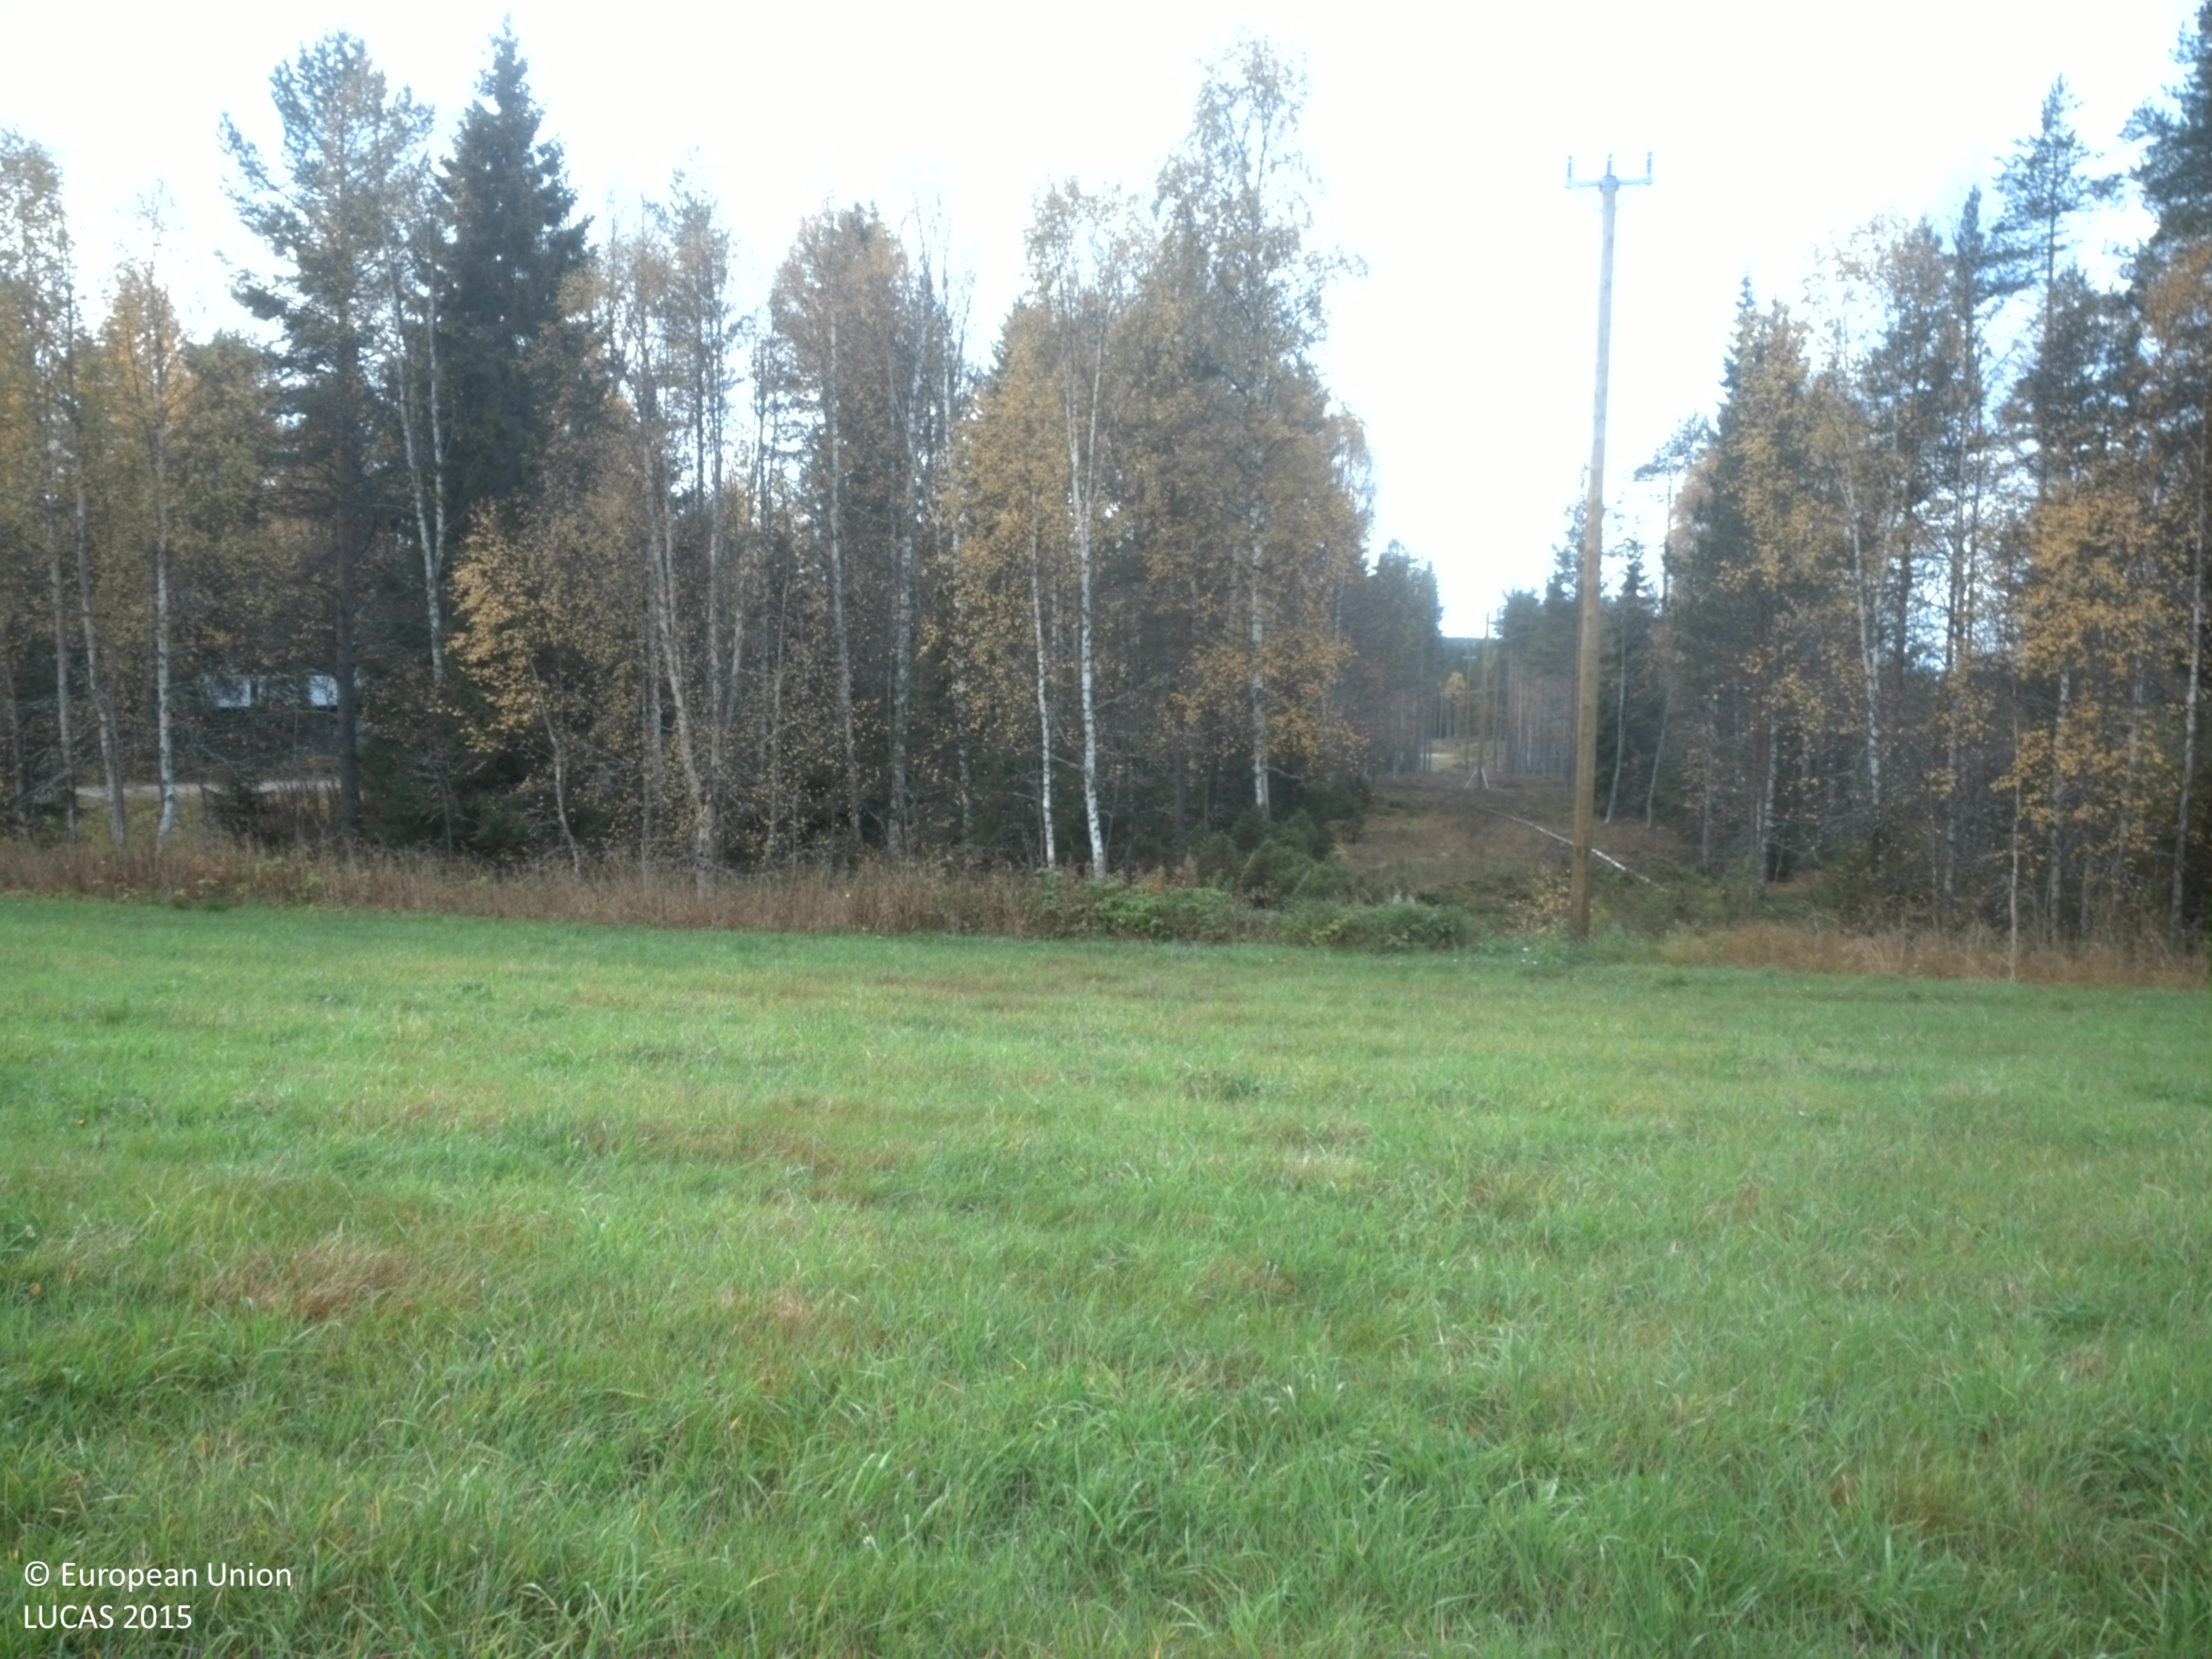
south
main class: Grassland
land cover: Grassland without tree/shrub cover
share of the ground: > 75 %
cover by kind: herbaceous plants 100 %
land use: Agriculture (excluding fallow land and kitchen gardens)
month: September
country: SE
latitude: 64.2293
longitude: 19.9746
